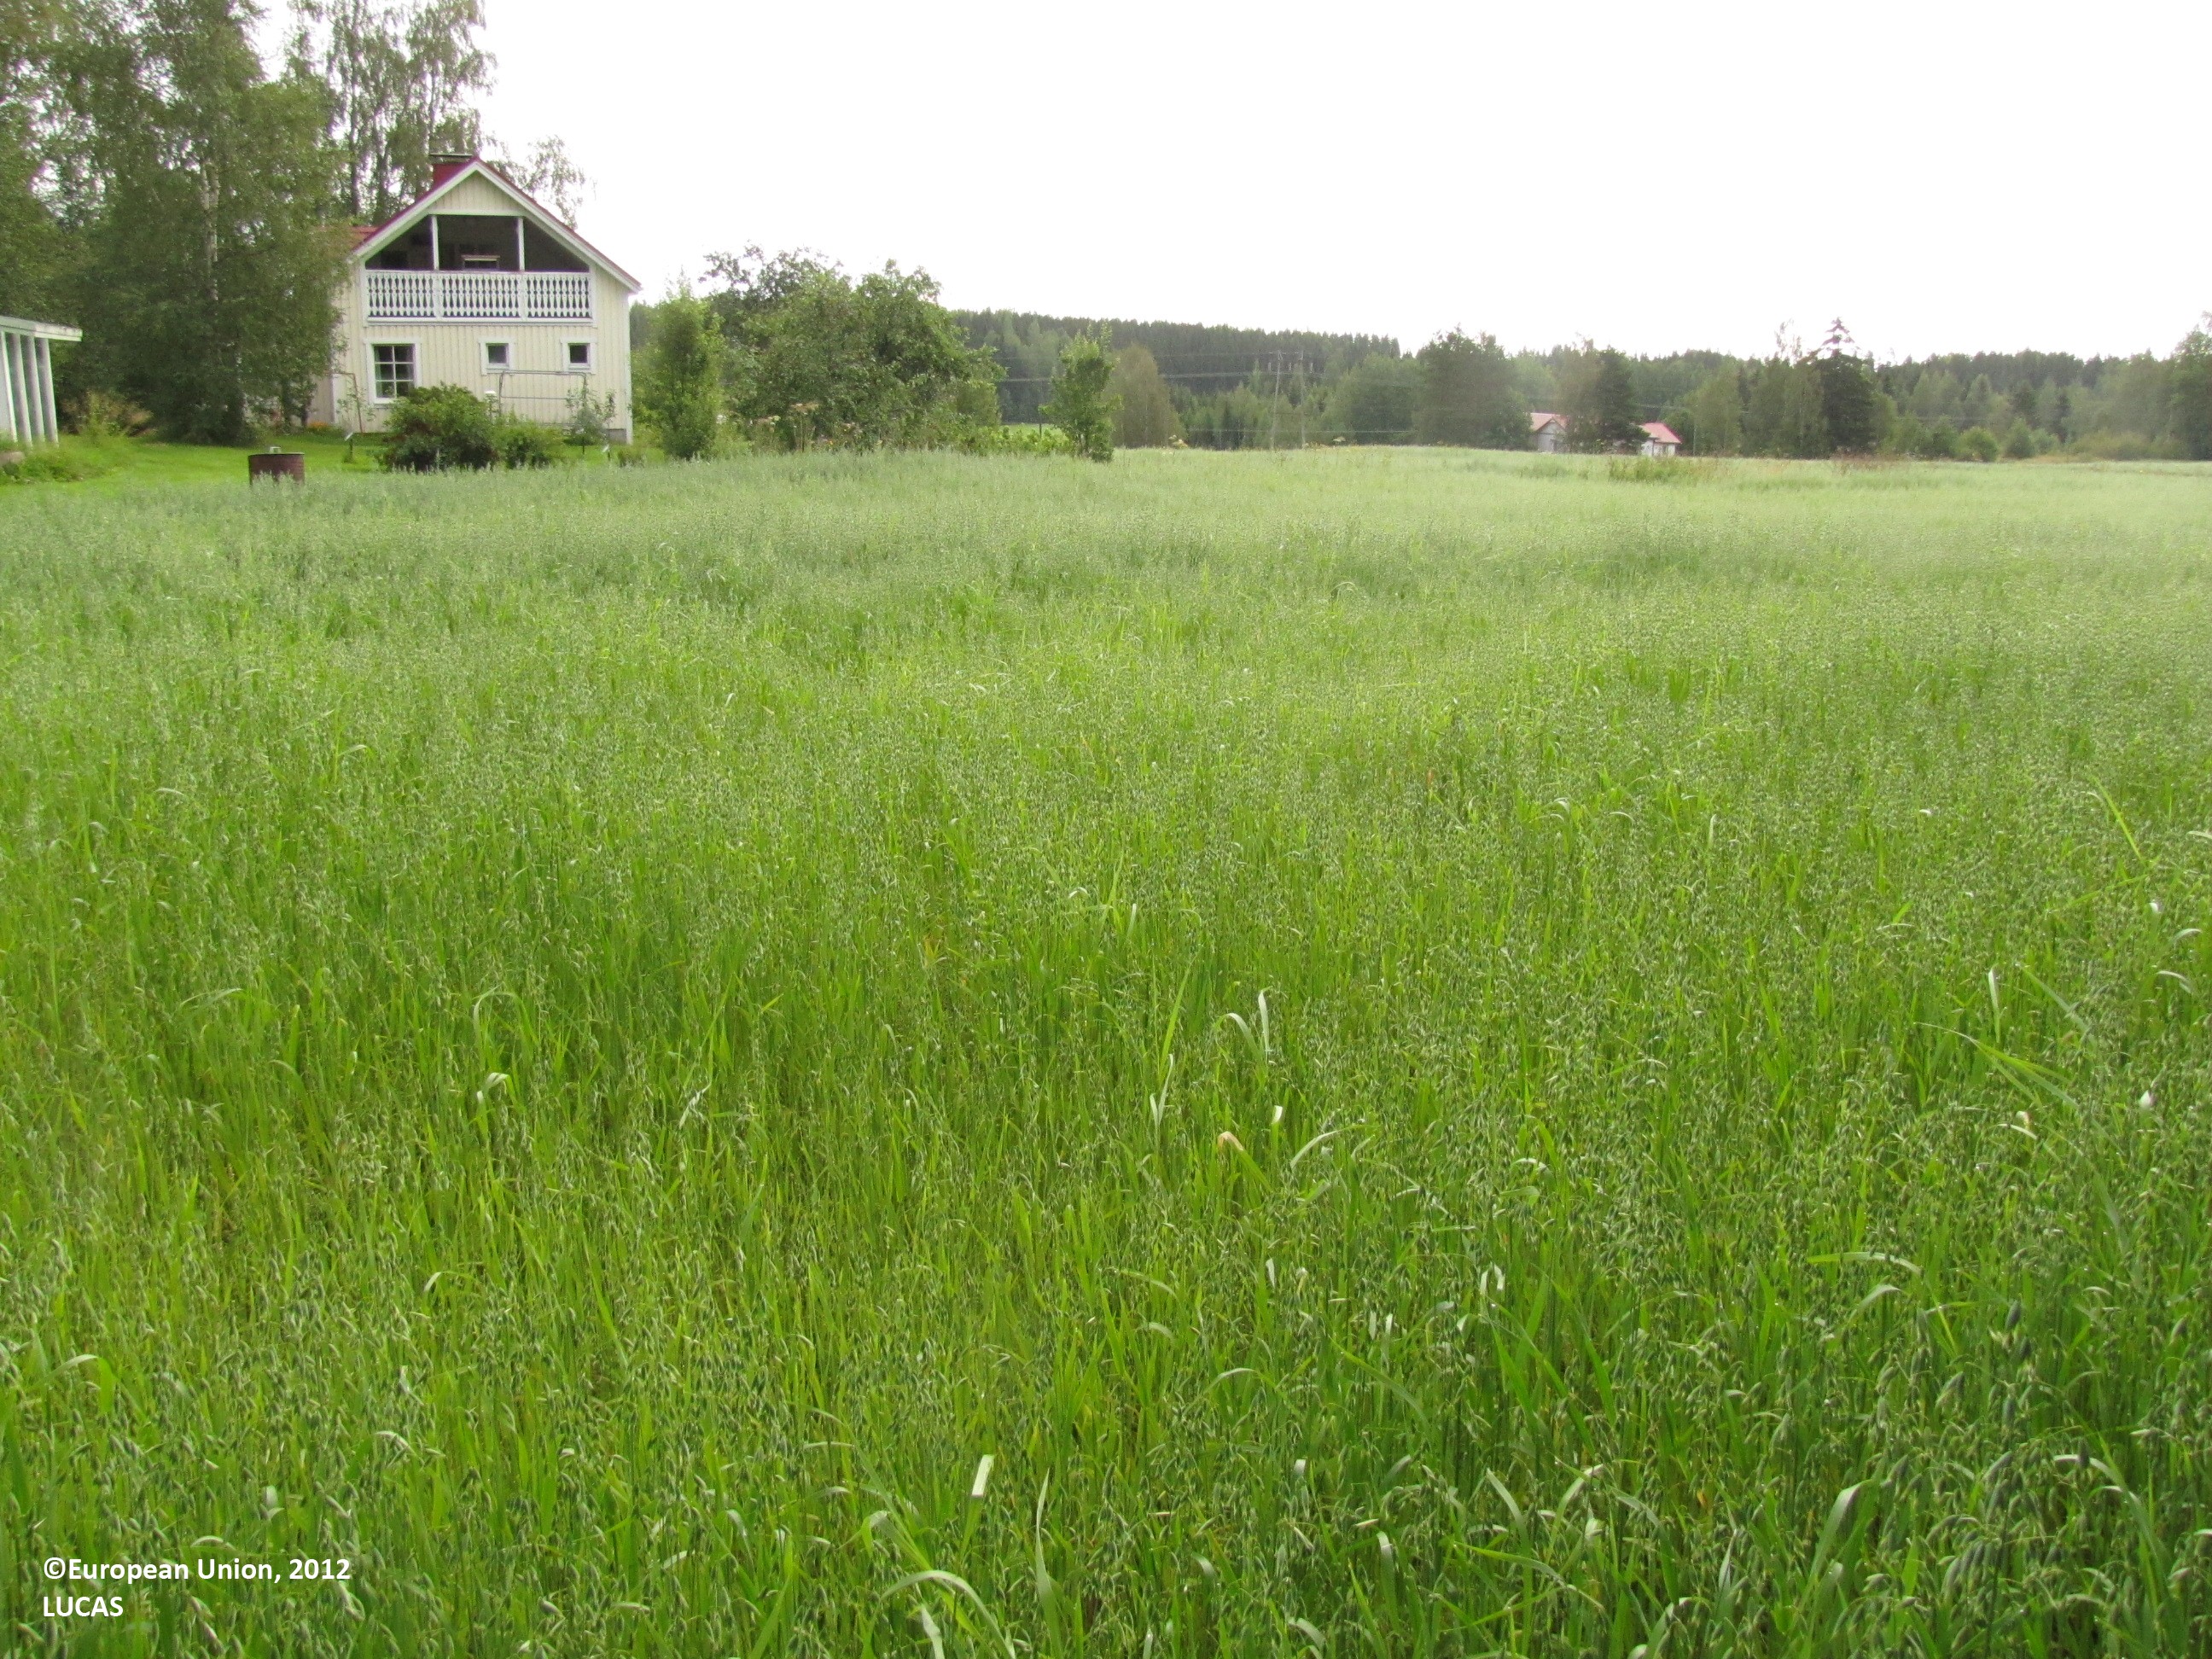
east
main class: Cropland
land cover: Oats
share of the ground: > 75 %
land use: Agriculture (excluding fallow land and kitchen gardens)
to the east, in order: Oats; Electric lines; Oats; Grass margins; Ditches and canals; Grass margins; Apple fruit; Grass margins; Oats; Electric lines; Grass margins; Ditches and canals; Grass margins; Tracks; Grass margins; Ditches and canals; Grass margins; Electric lines; Grassland without tree/shrub cover; Broadleaved woodland; Temporary grasslands; Electric lines; Grass margins; Ditches and canals; Grass margins; Electric lines
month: August
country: FI
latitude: 61.8119
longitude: 22.9532
